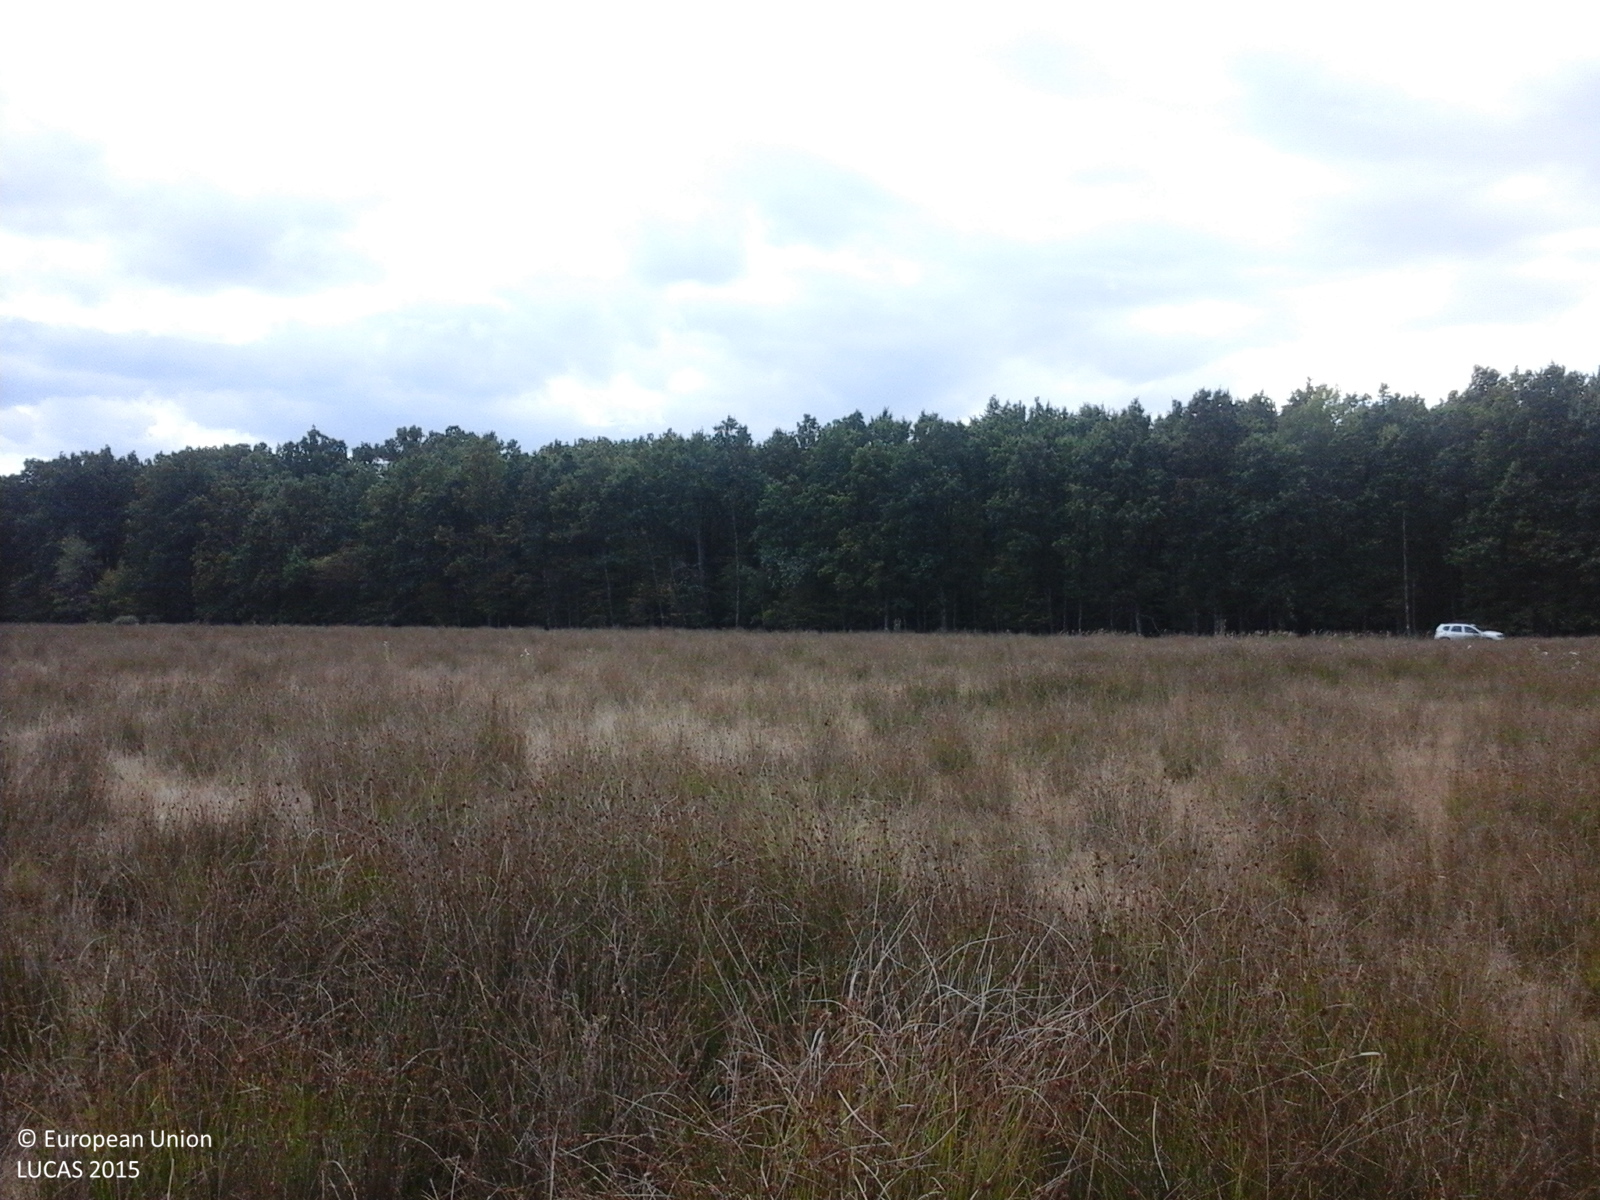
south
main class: Grassland
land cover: Grassland without tree/shrub cover
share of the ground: > 75 %
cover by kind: herbaceous plants 100 %
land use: Agriculture (excluding fallow land and kitchen gardens)
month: September
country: RO
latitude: 47.8827
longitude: 23.1887
